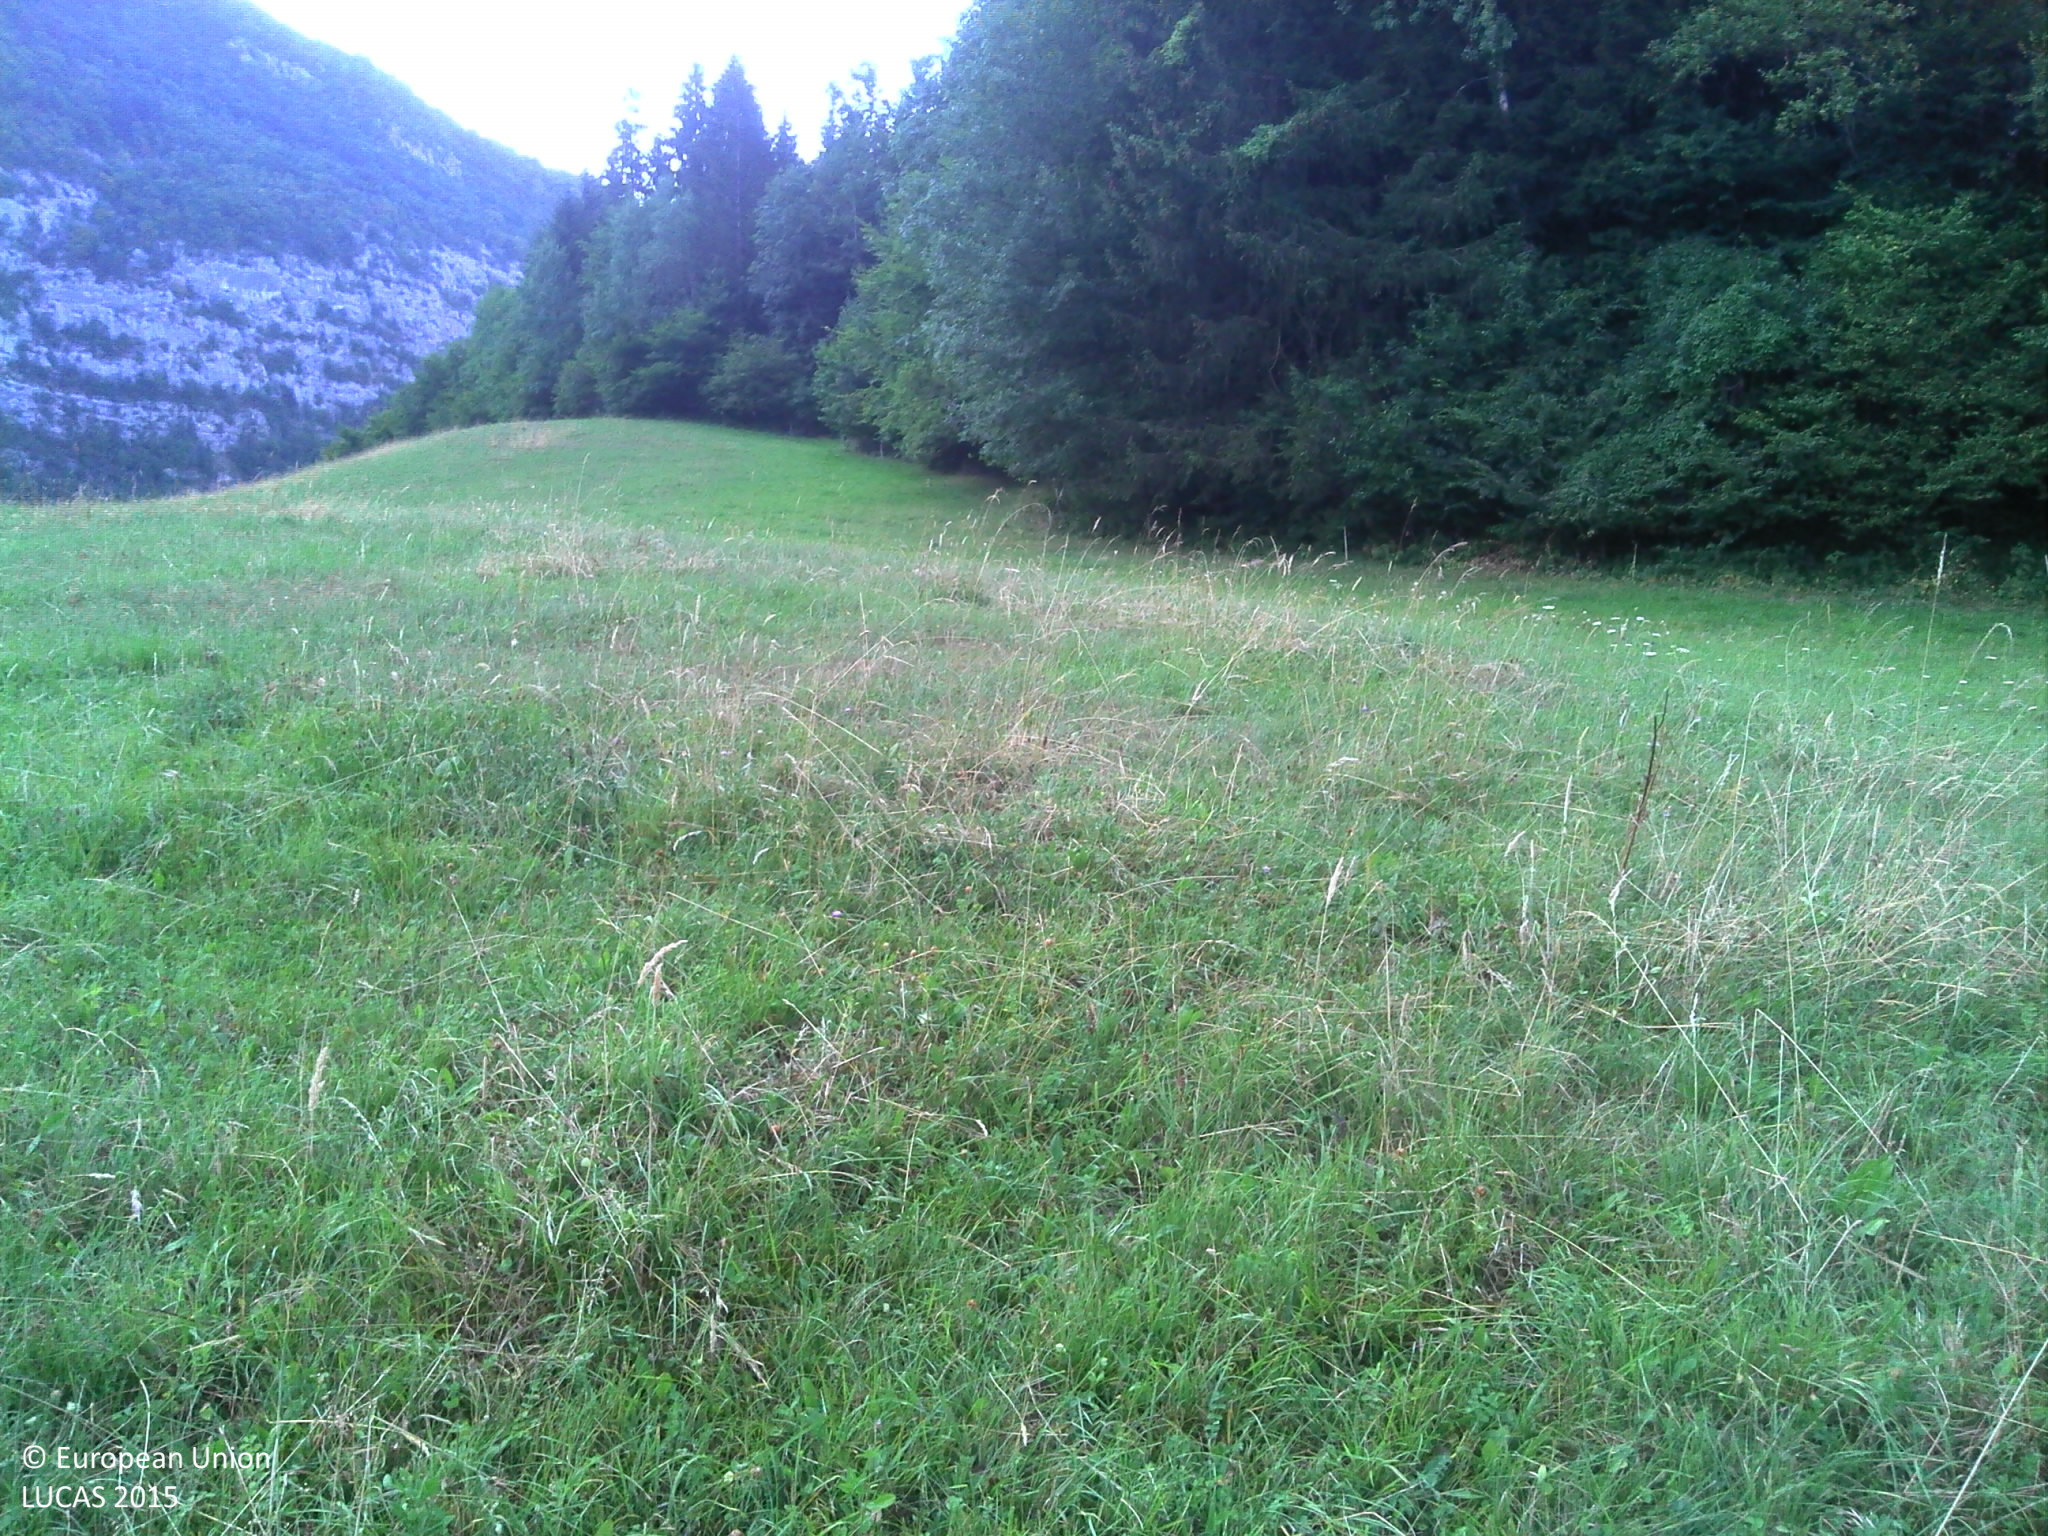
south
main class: Grassland
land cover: Grassland without tree/shrub cover
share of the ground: > 75 %
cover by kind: herbaceous plants 100 %
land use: Agriculture (excluding fallow land and kitchen gardens)
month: July
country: FR
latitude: 45.9231
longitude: 6.2000
